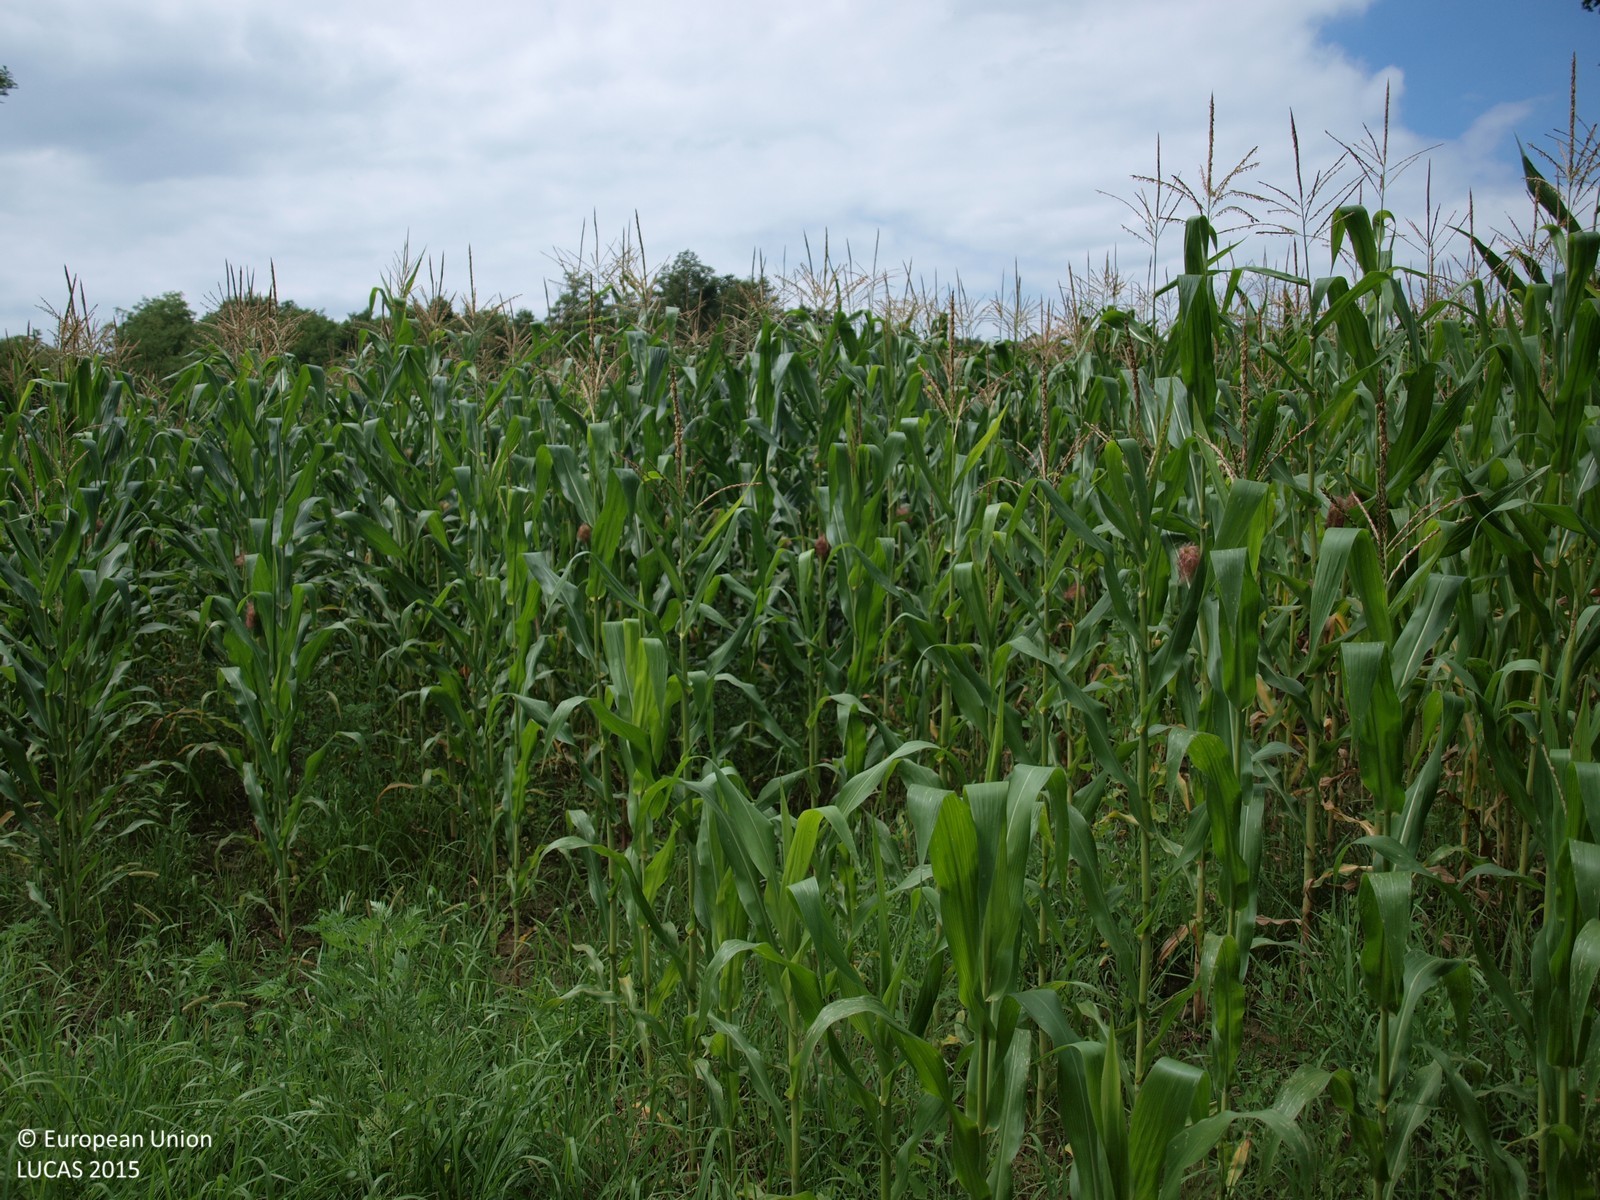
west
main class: Cropland
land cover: Maize
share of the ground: > 75 %
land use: Agriculture (excluding fallow land and kitchen gardens)
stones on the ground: < 10 %
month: August
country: HR
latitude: 45.9631
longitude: 16.3608
